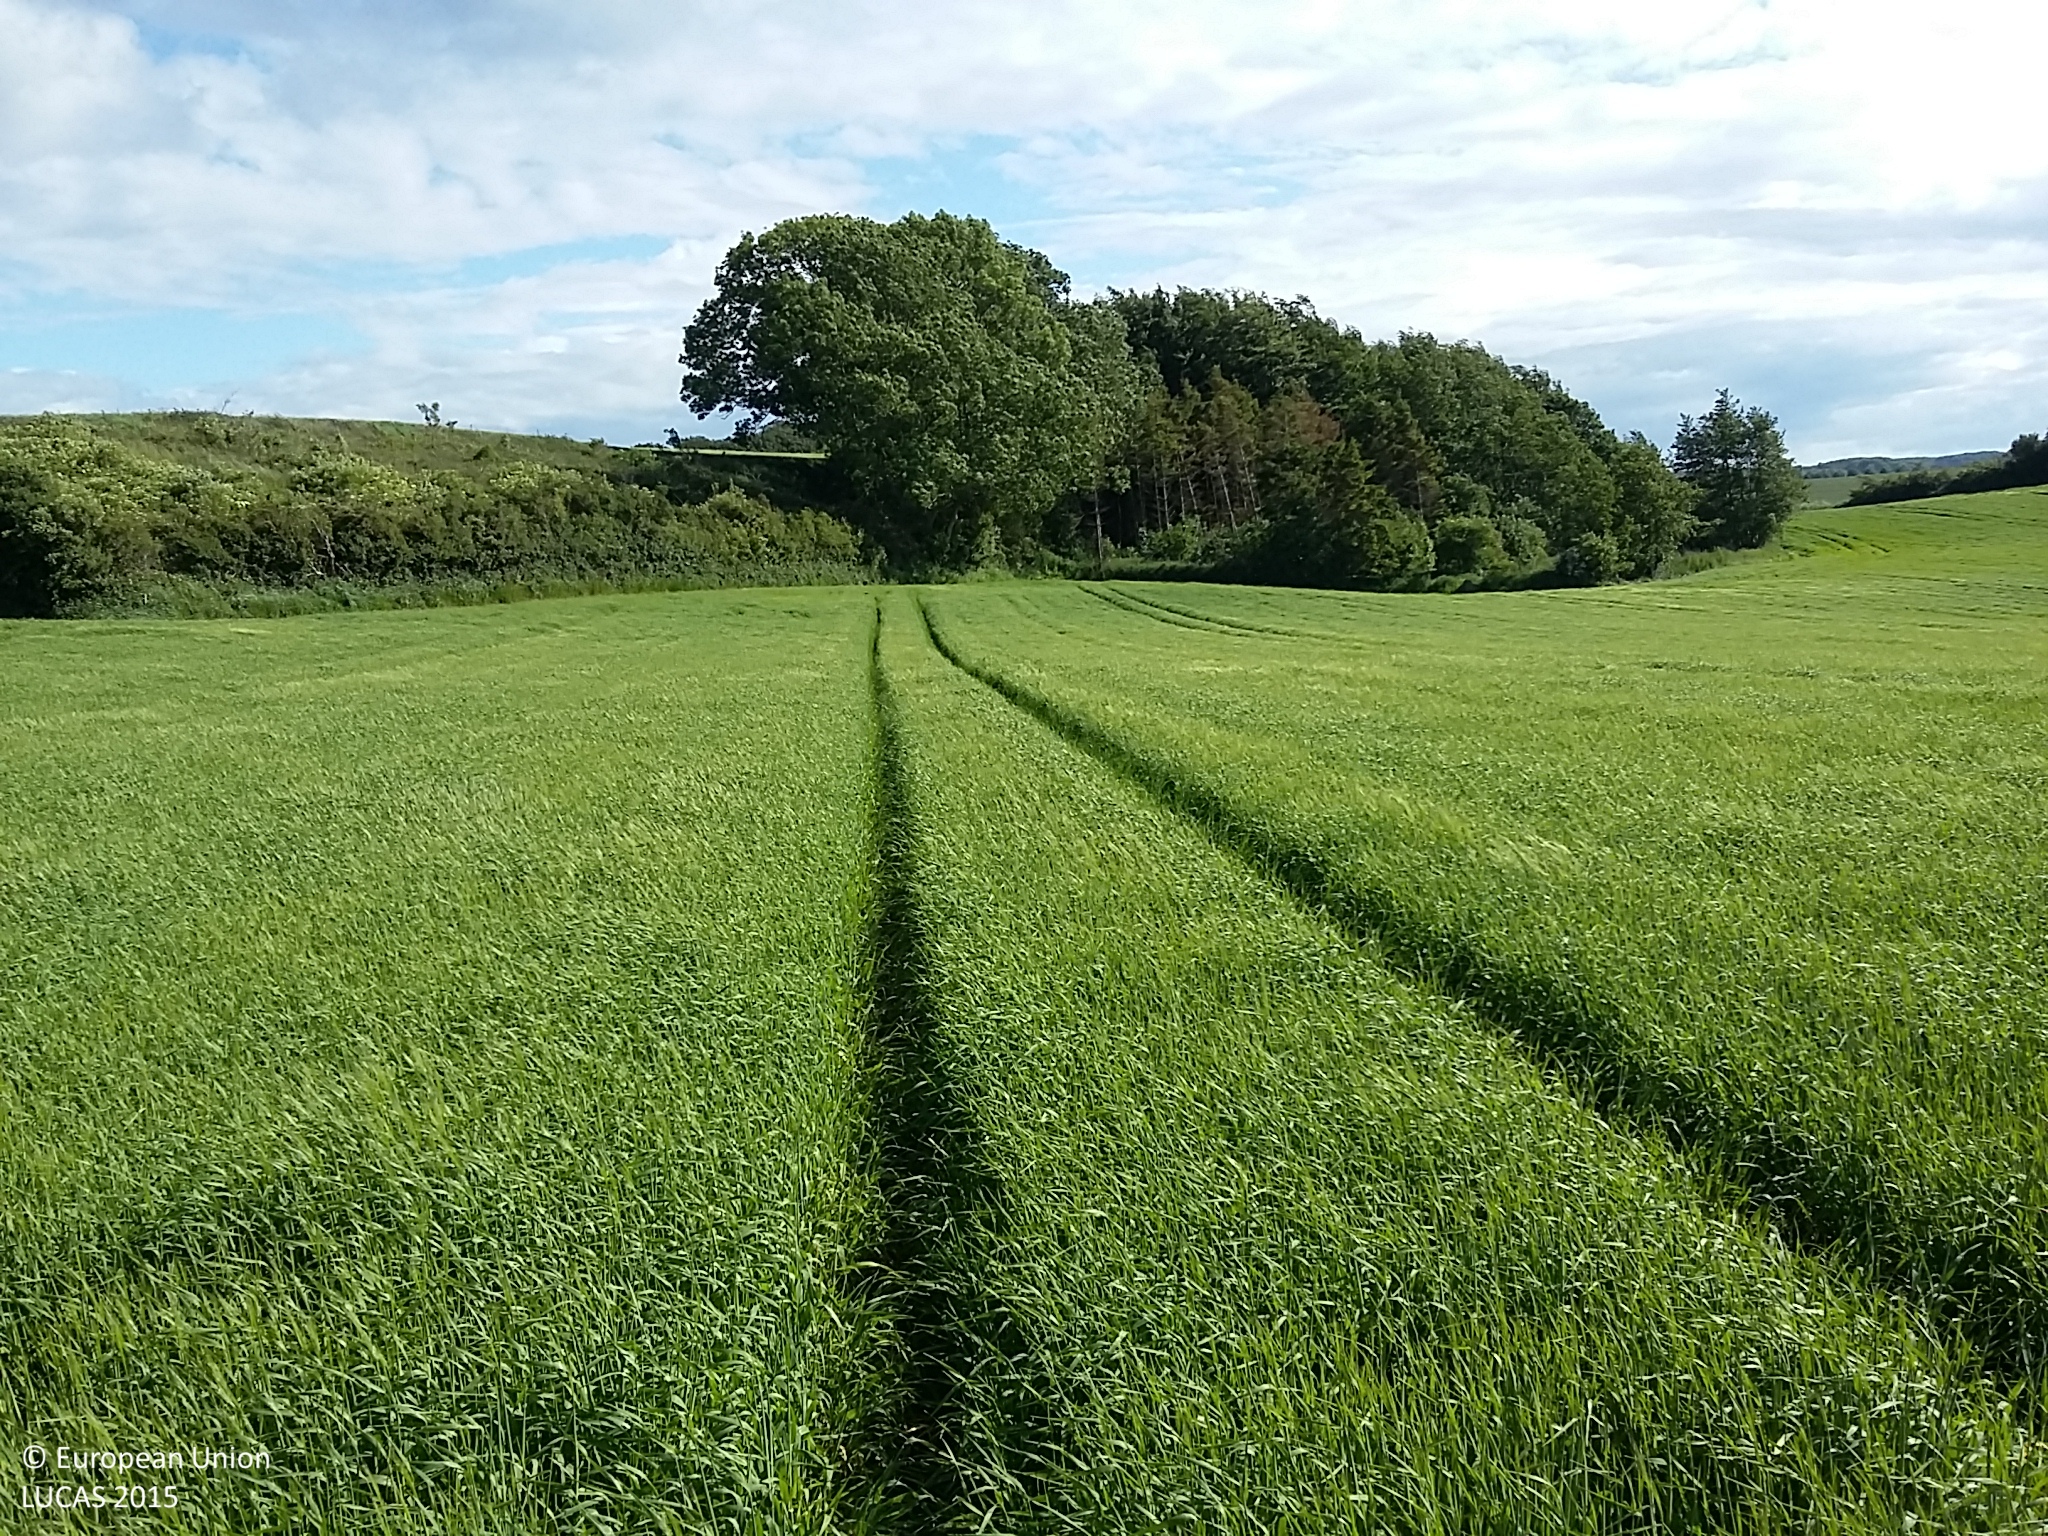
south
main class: Cropland
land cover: Barley
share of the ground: > 75 %
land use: Agriculture (excluding fallow land and kitchen gardens)
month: June
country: DK
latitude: 54.8374
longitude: 10.7624
